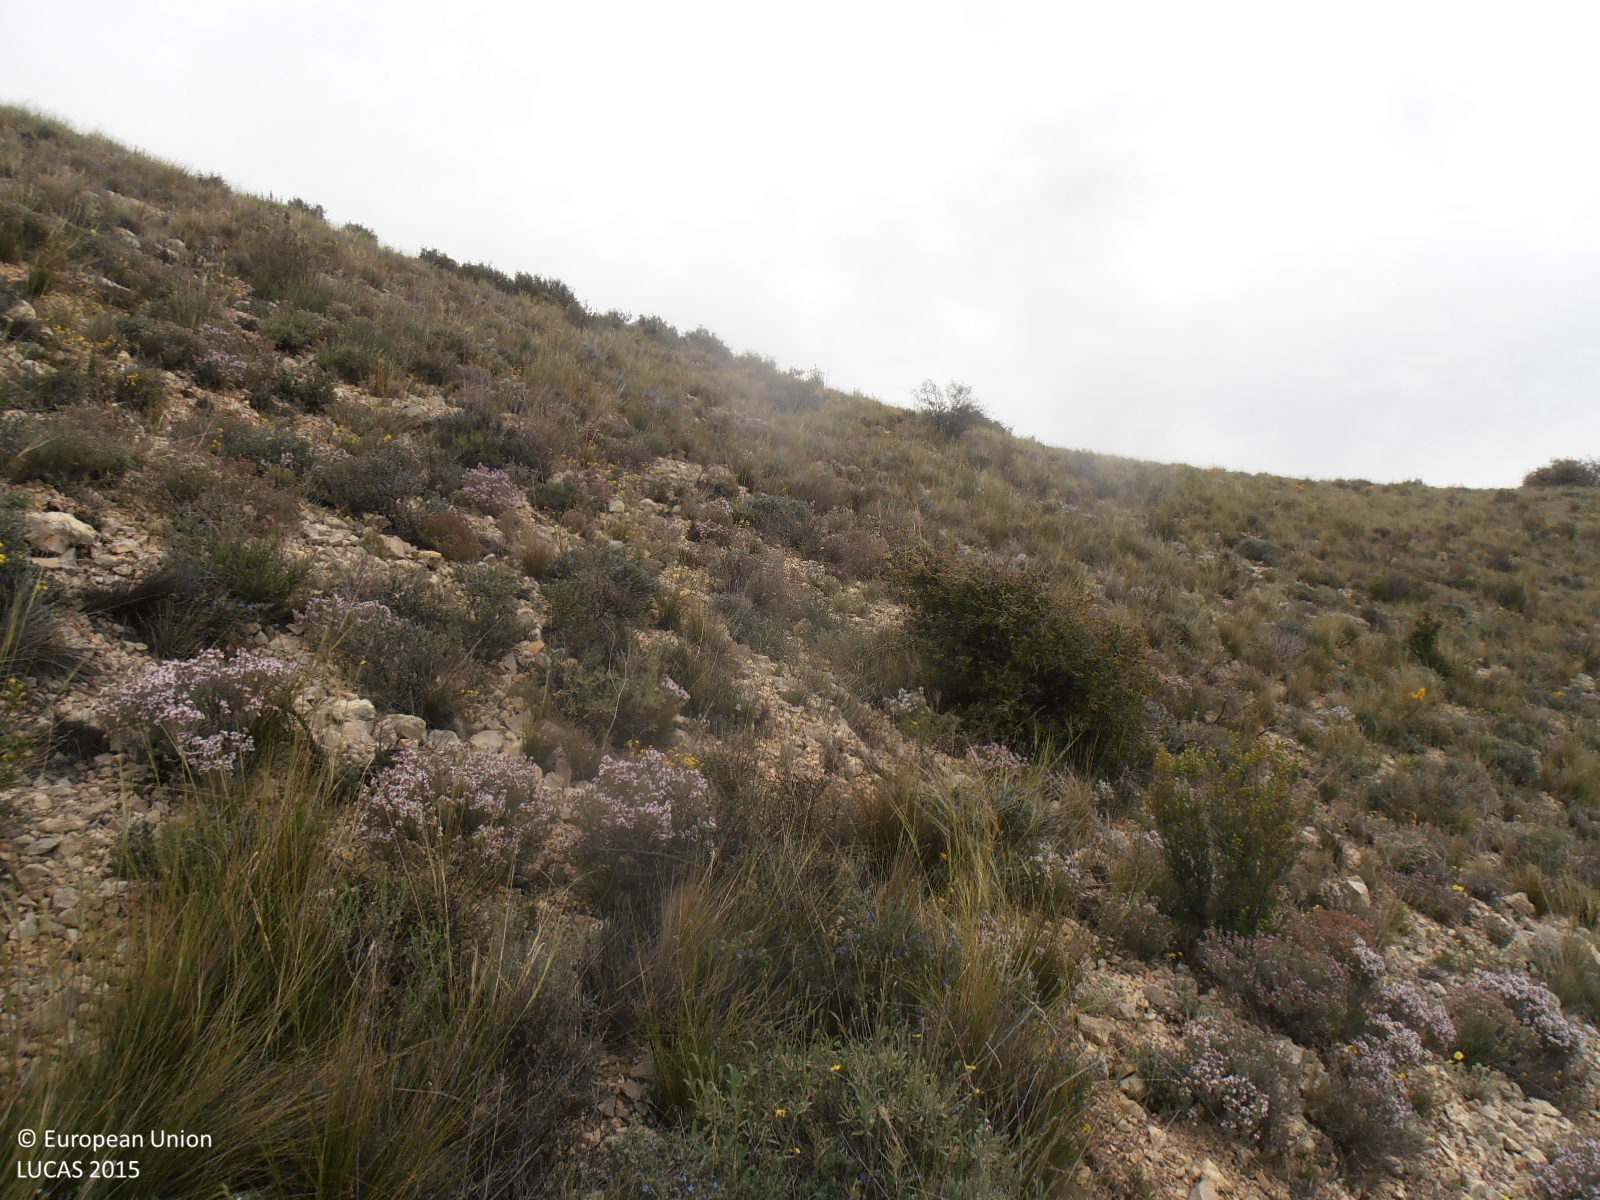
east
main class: Shrubland
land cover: Shrubland without tree cover
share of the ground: > 75 %
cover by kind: shrubs 50 %, consolidated bare surface 35 %, herbaceous plants 15 %
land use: Semi-natural and natural areas not in use
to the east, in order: Shrubland without tree cover
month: April
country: ES
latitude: 41.1204
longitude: -0.8669
